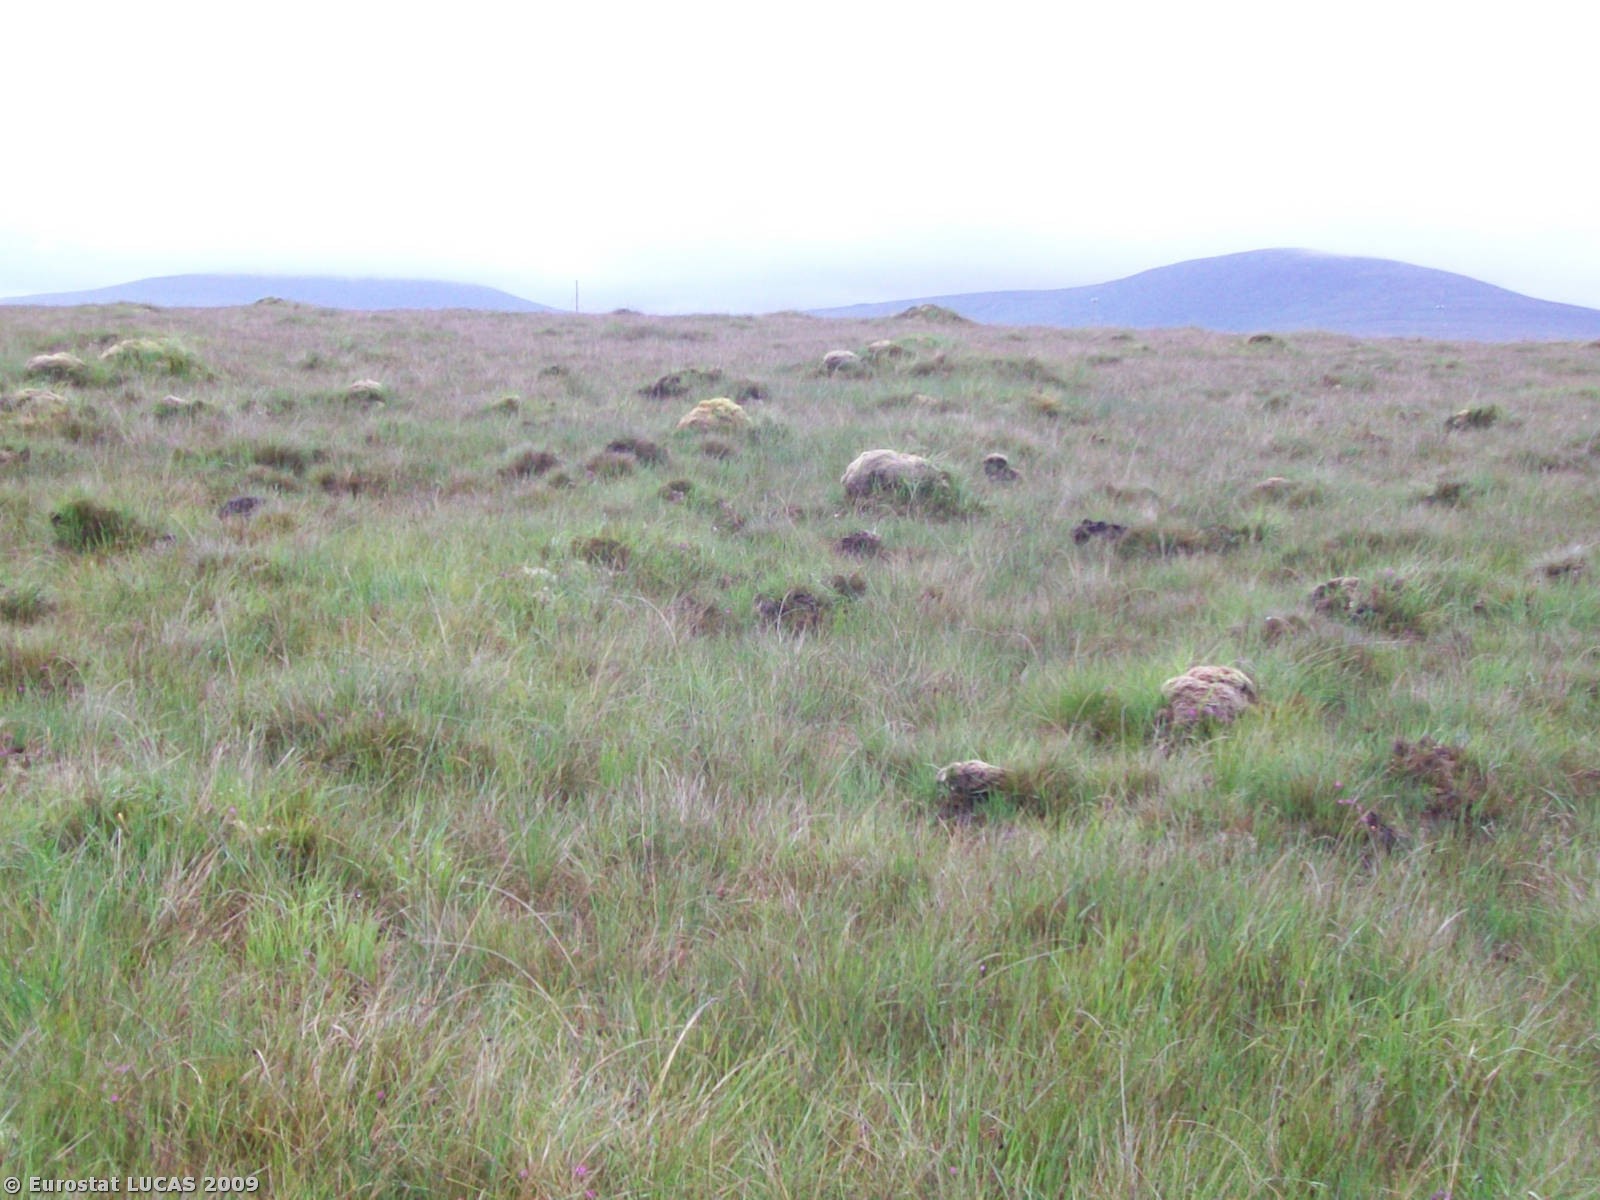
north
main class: Wetlands
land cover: Peatbogs
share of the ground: > 75 %
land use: Unused
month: July
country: IE
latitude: 53.9955
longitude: -9.7522
